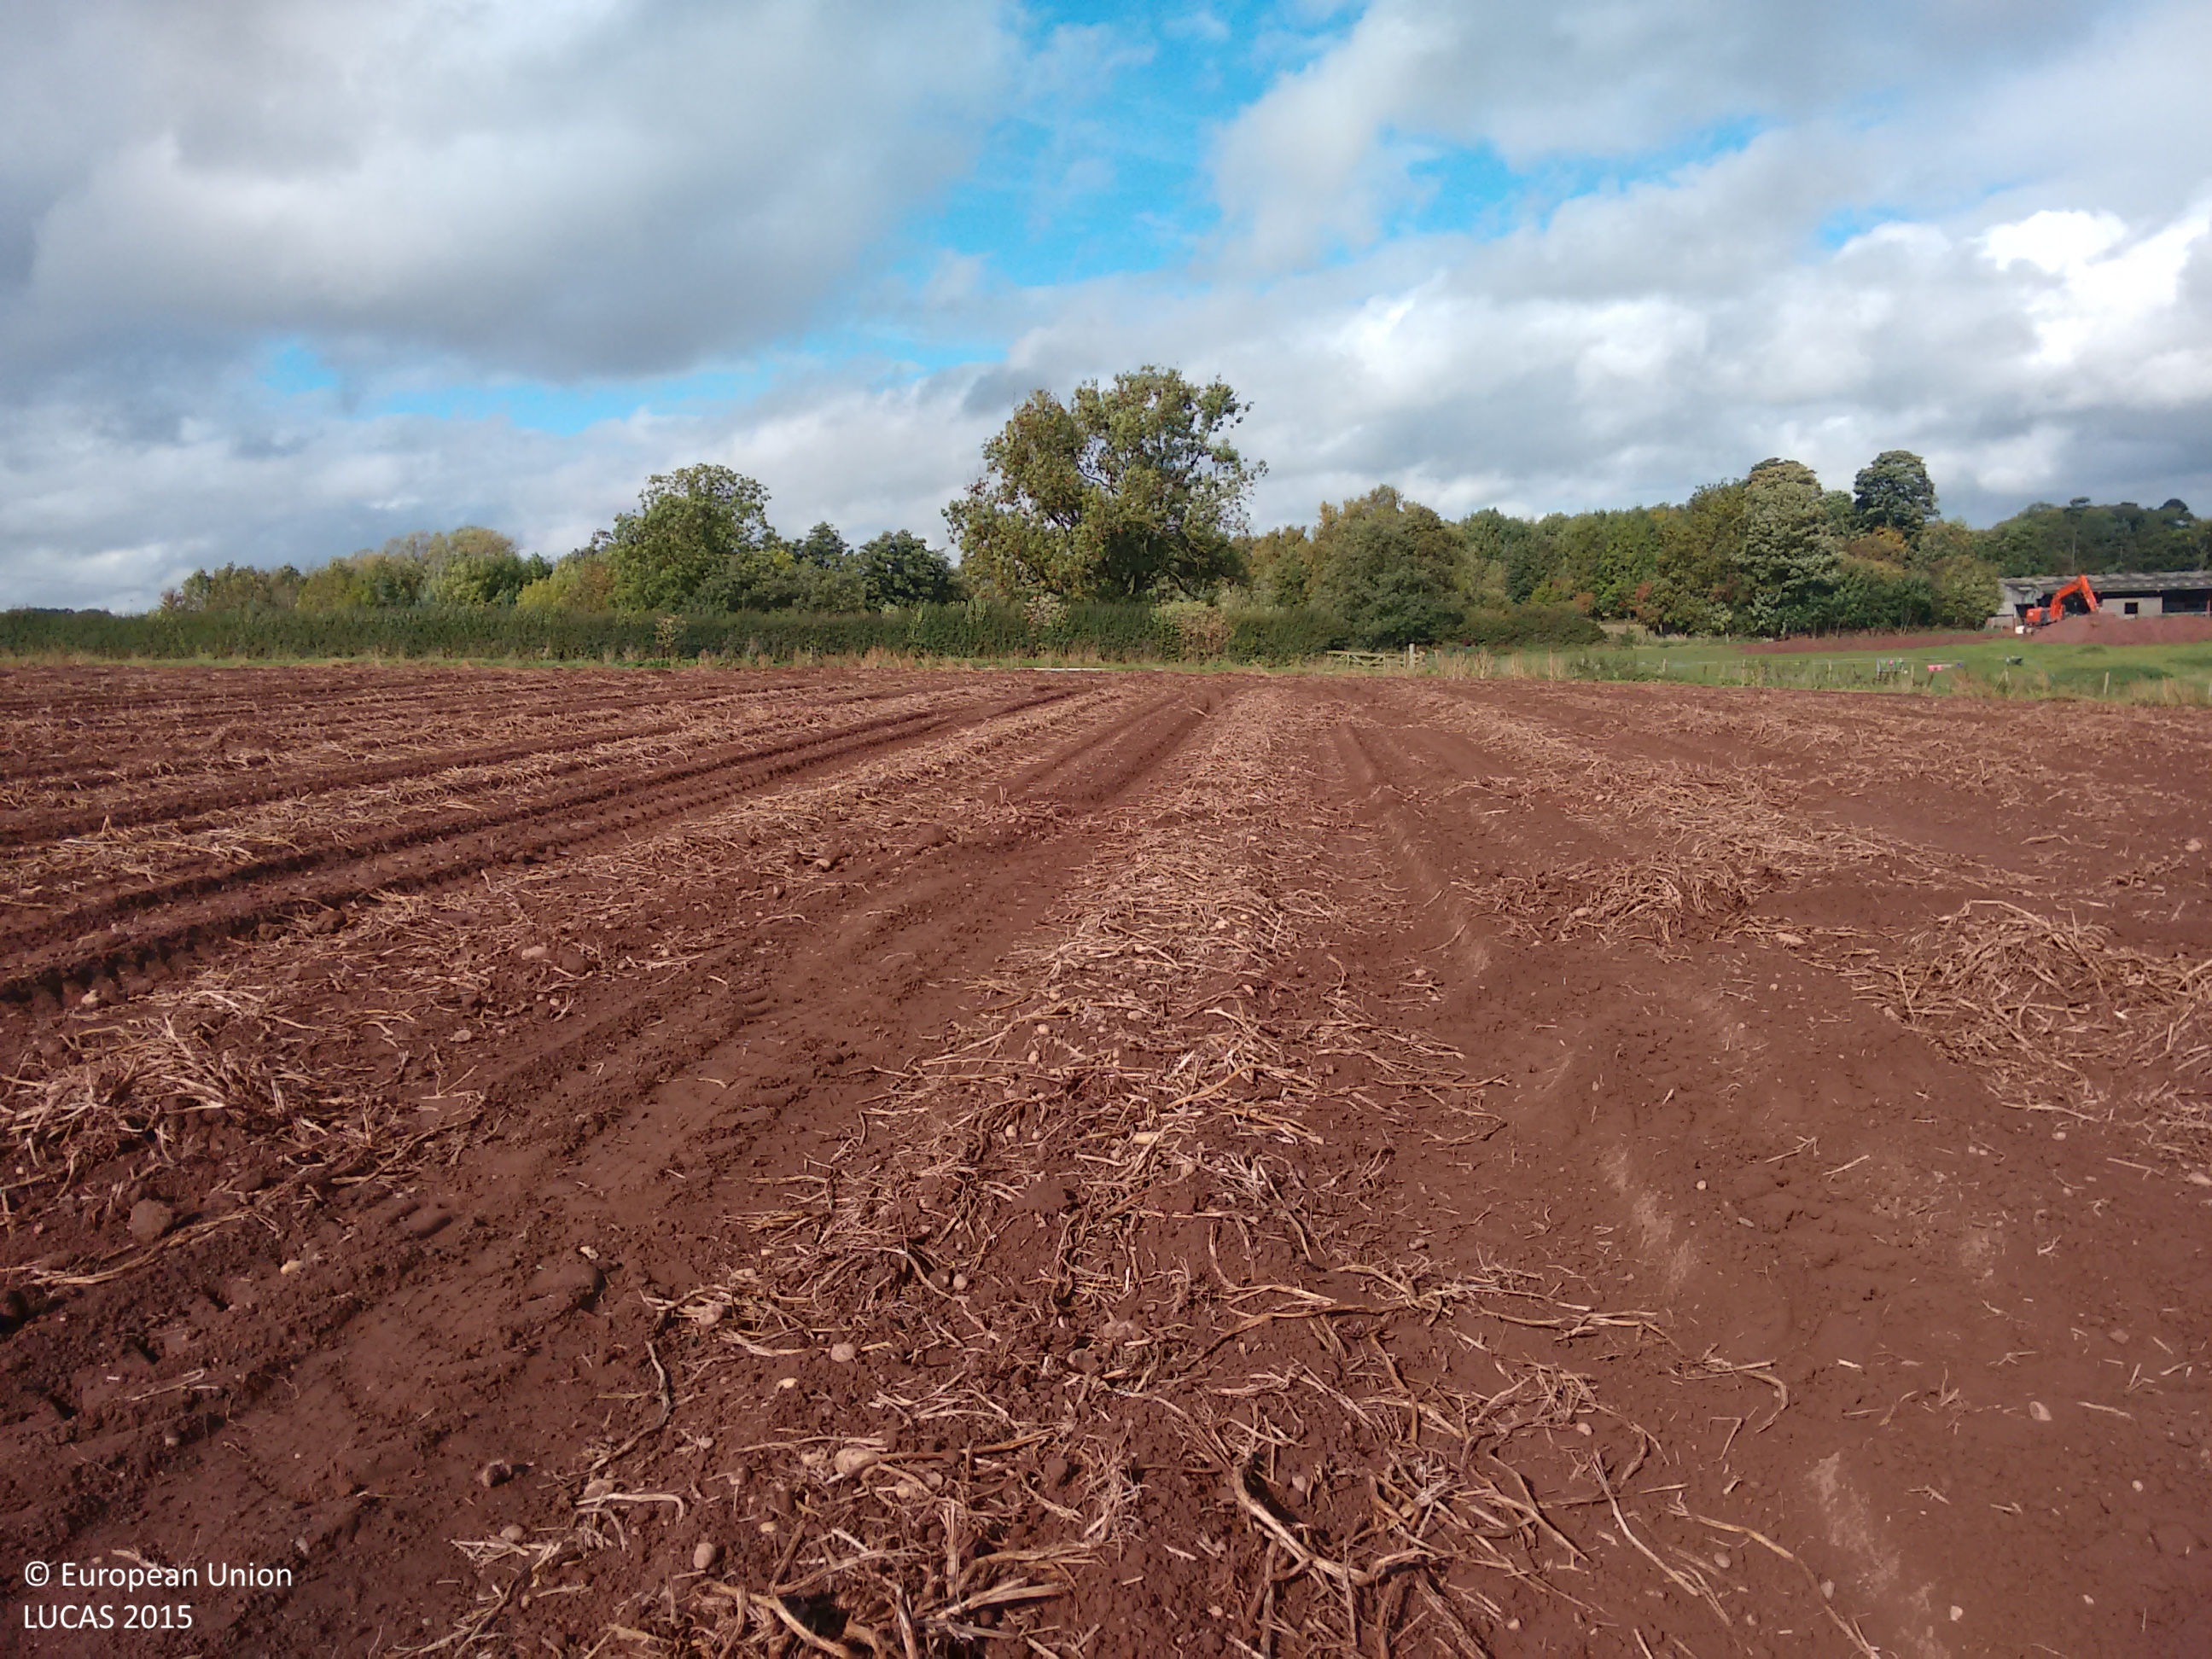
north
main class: Cropland
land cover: Potatoes
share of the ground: < 10 %
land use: Agriculture (excluding fallow land and kitchen gardens)
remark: Harvested field
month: October
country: GB
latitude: 52.7107
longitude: -2.3642
